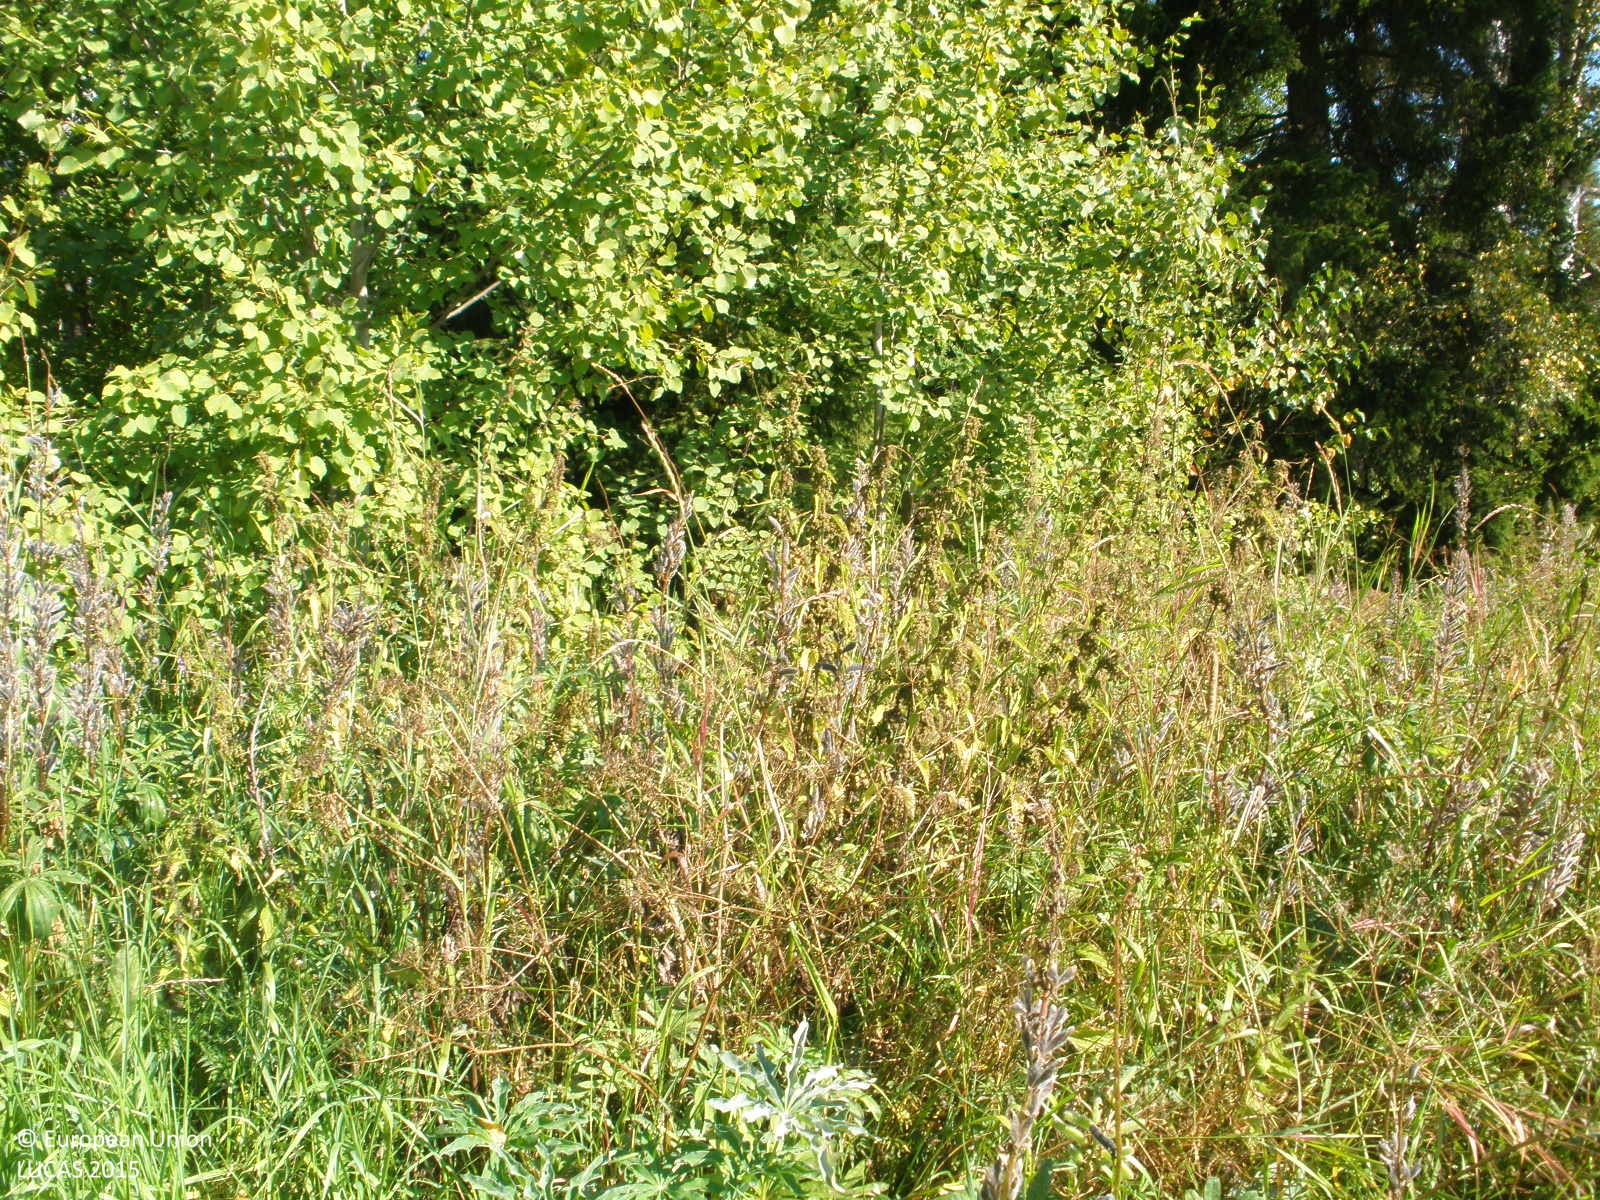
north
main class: Grassland
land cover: Grassland without tree/shrub cover
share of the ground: > 75 %
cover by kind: herbaceous plants 100 %
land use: Agriculture (excluding fallow land and kitchen gardens)
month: August
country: FI
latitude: 60.6385
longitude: 23.5618
